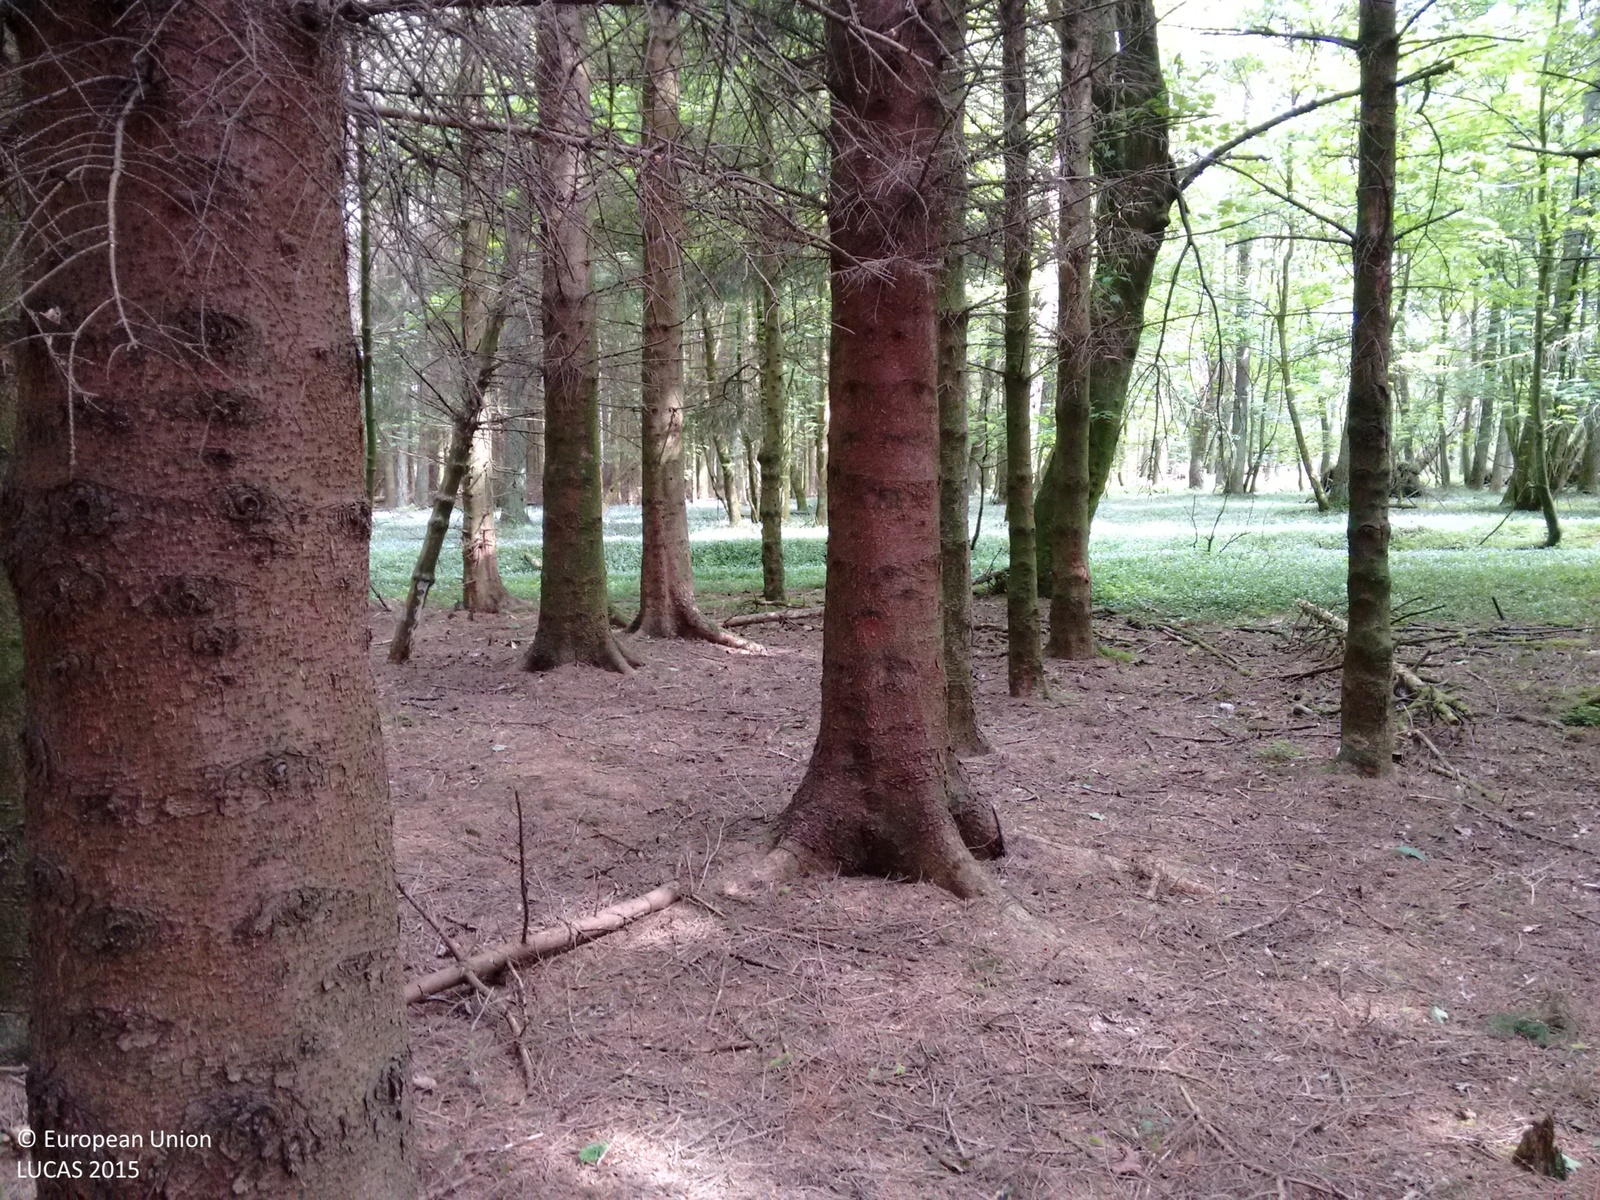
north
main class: Woodland
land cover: Pine dominated coniferous woodland
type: exotic forest
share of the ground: > 75 %
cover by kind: coniferous forest trees 95 %, broadleaved forest trees 5 %
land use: Forestry
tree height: > 5 m
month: June
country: GB
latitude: 56.2101
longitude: -3.4078
